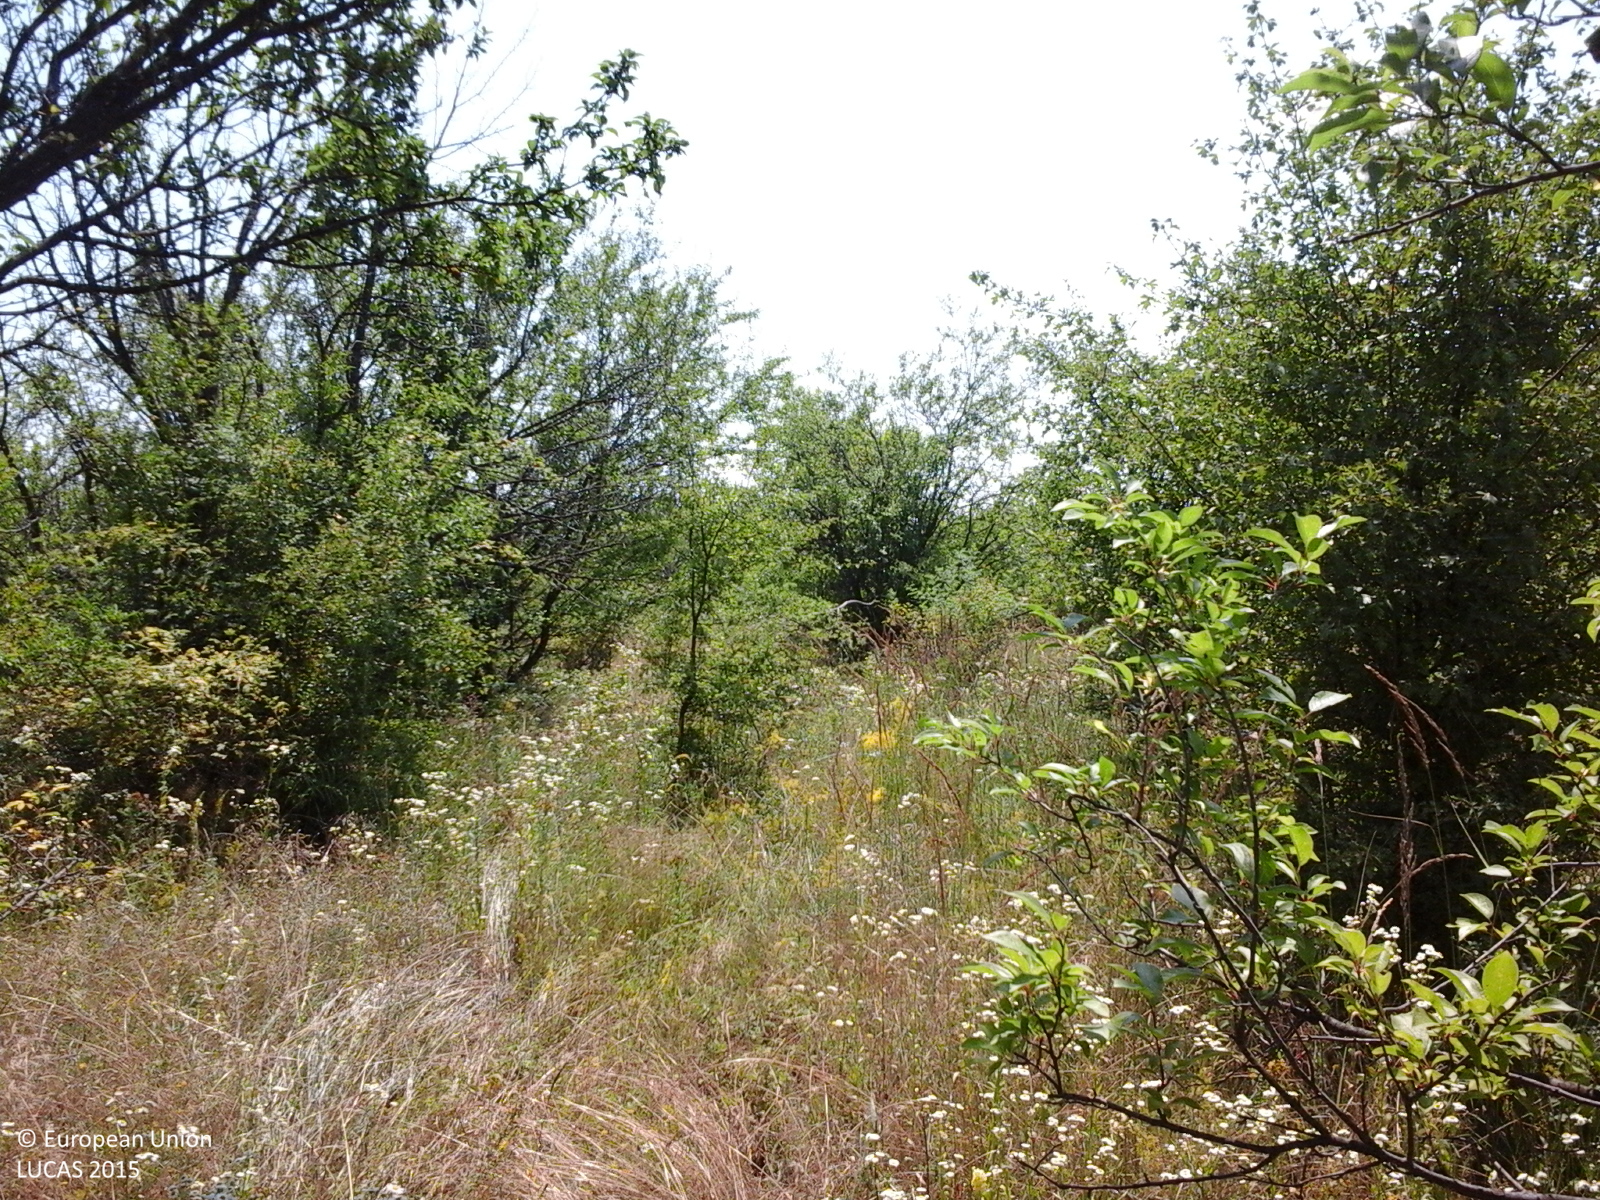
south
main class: Cropland
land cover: Other fruit trees and berries
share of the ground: > 75 %
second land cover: Shrubland without tree cover
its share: 50 - 75 %
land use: Abandoned areas
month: July
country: RO
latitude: 44.7515
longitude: 24.5112
